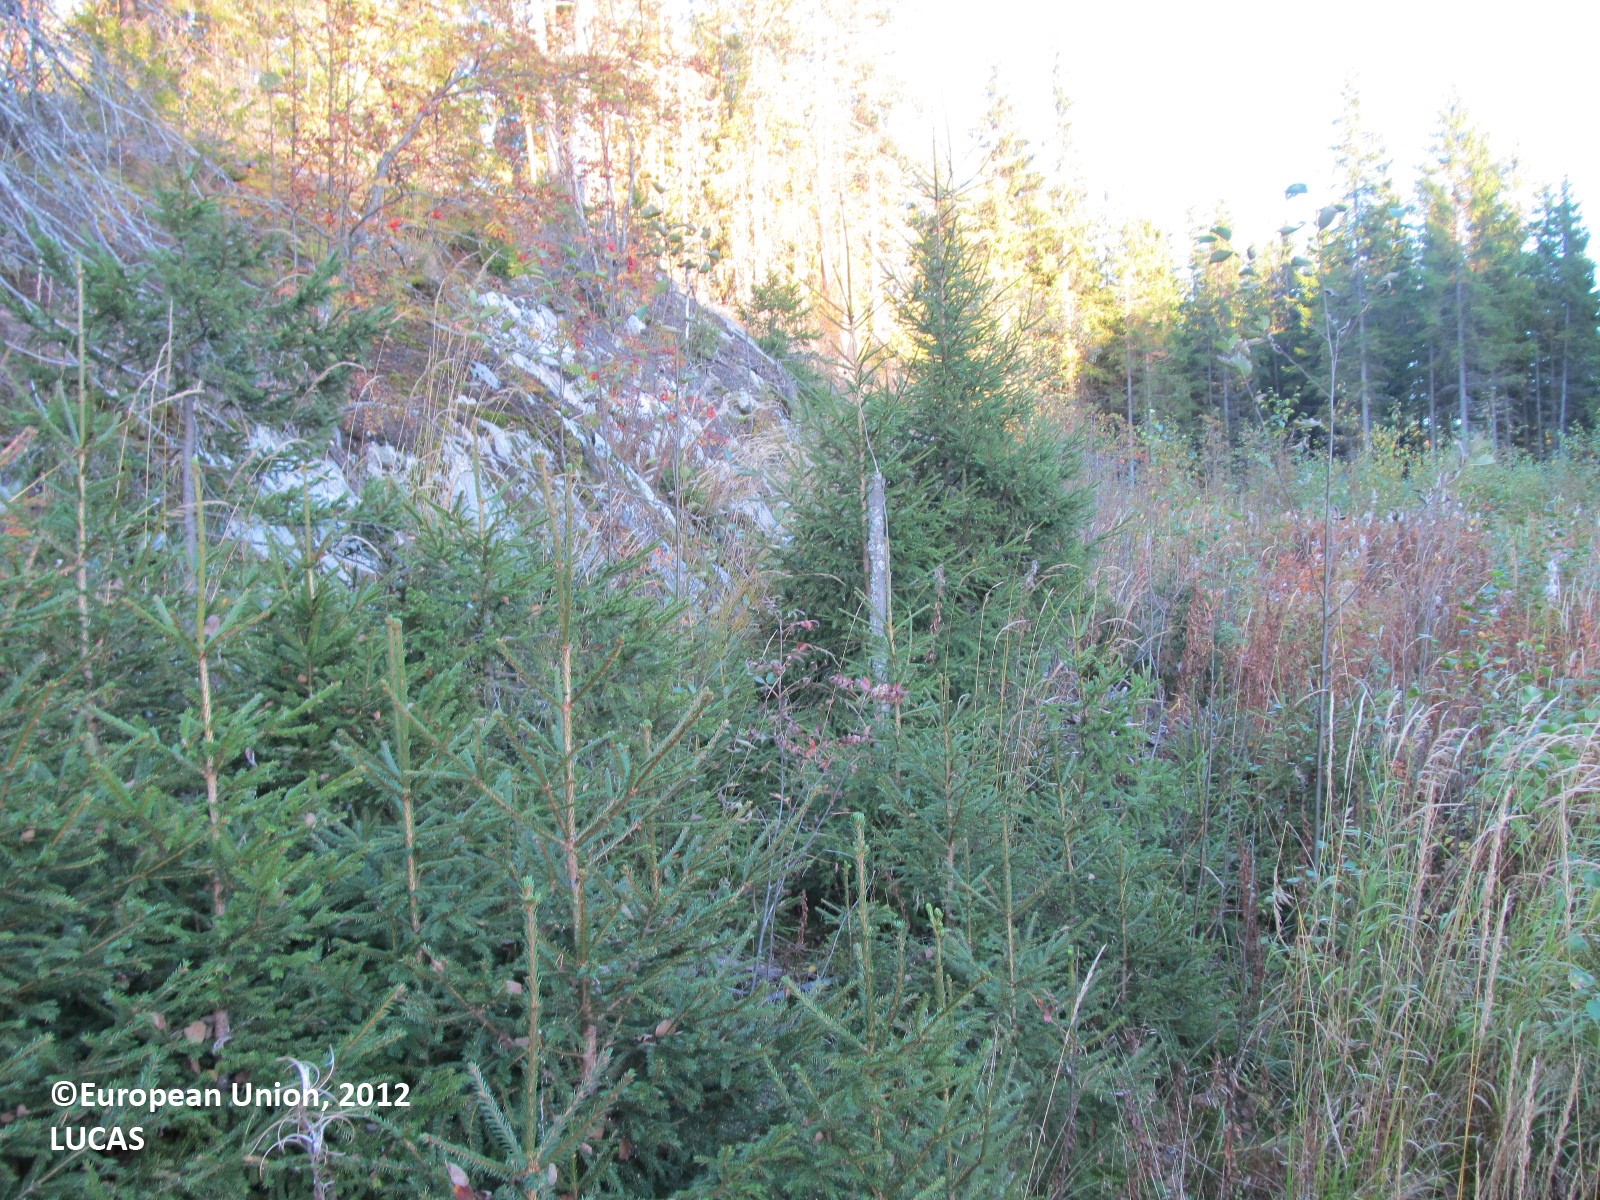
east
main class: Woodland
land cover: Broadleaved woodland
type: boreal forest
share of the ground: 25 - 50 %
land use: Forestry
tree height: > 5 m
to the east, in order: Broadleaved woodland; Ditches and canals; Paved roads, cycling and walking lanes; Broadleaved woodland; Shrubland without tree cover; Shrubland with sparse tree cover; Spruce dominated coniferous woodland
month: September
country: FI
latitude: 62.3991
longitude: 28.6455
